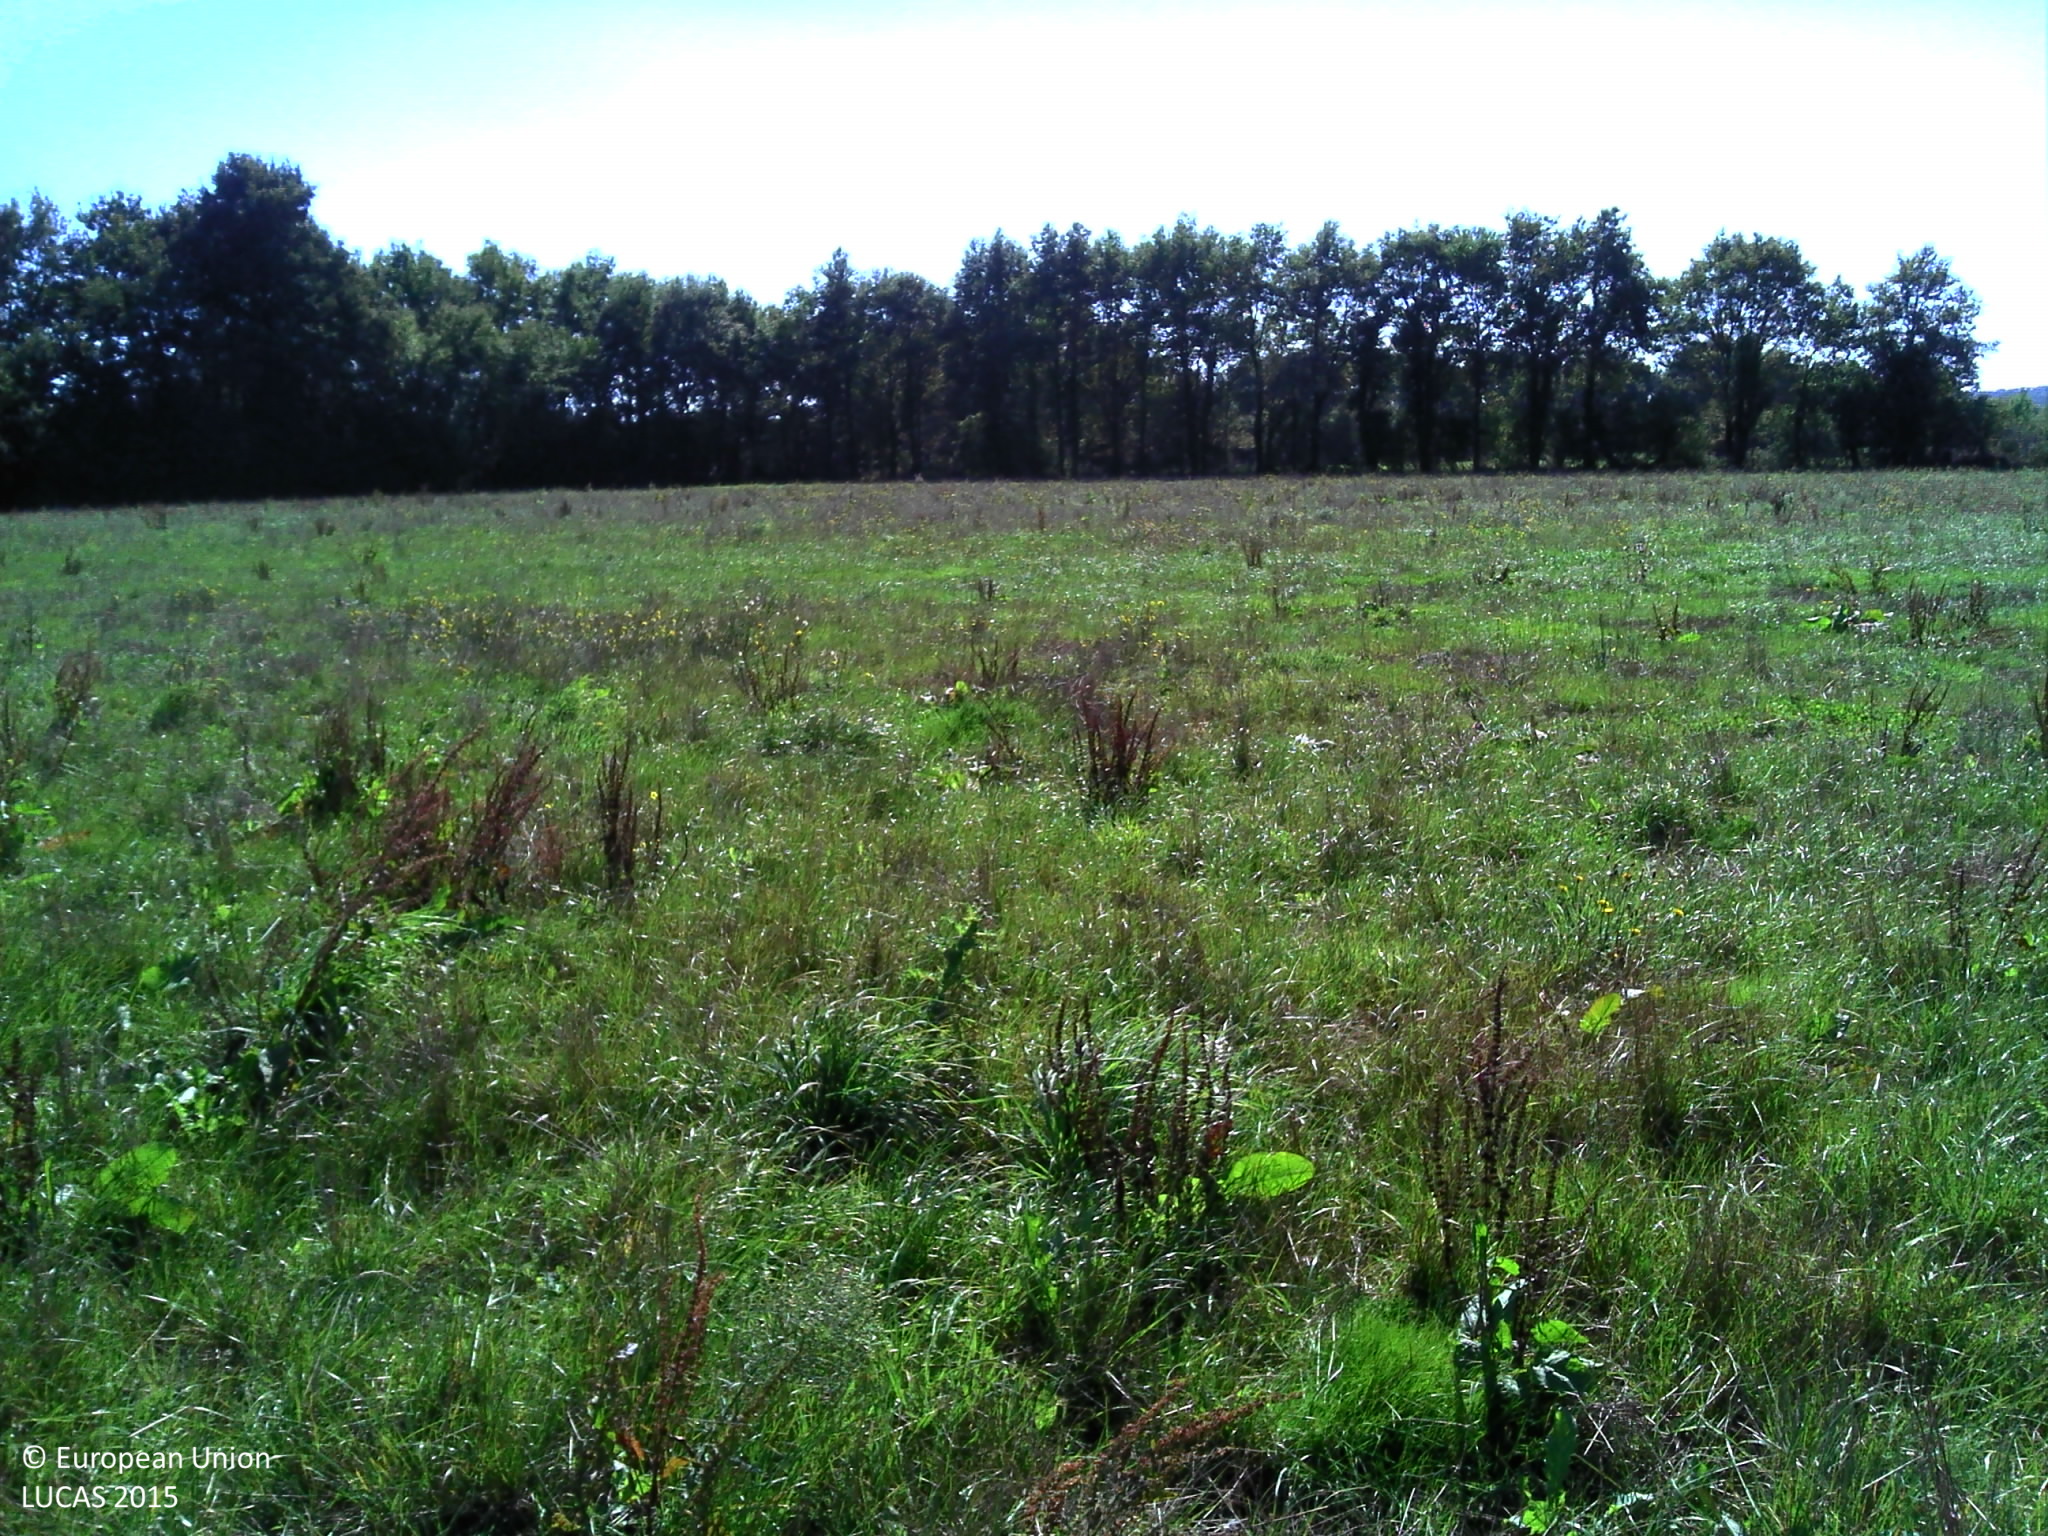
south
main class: Grassland
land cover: Grassland without tree/shrub cover
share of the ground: > 75 %
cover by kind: herbaceous plants 100 %
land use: Agriculture (excluding fallow land and kitchen gardens)
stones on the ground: < 10 %
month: September
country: FR
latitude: 46.6044
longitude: -1.3026
